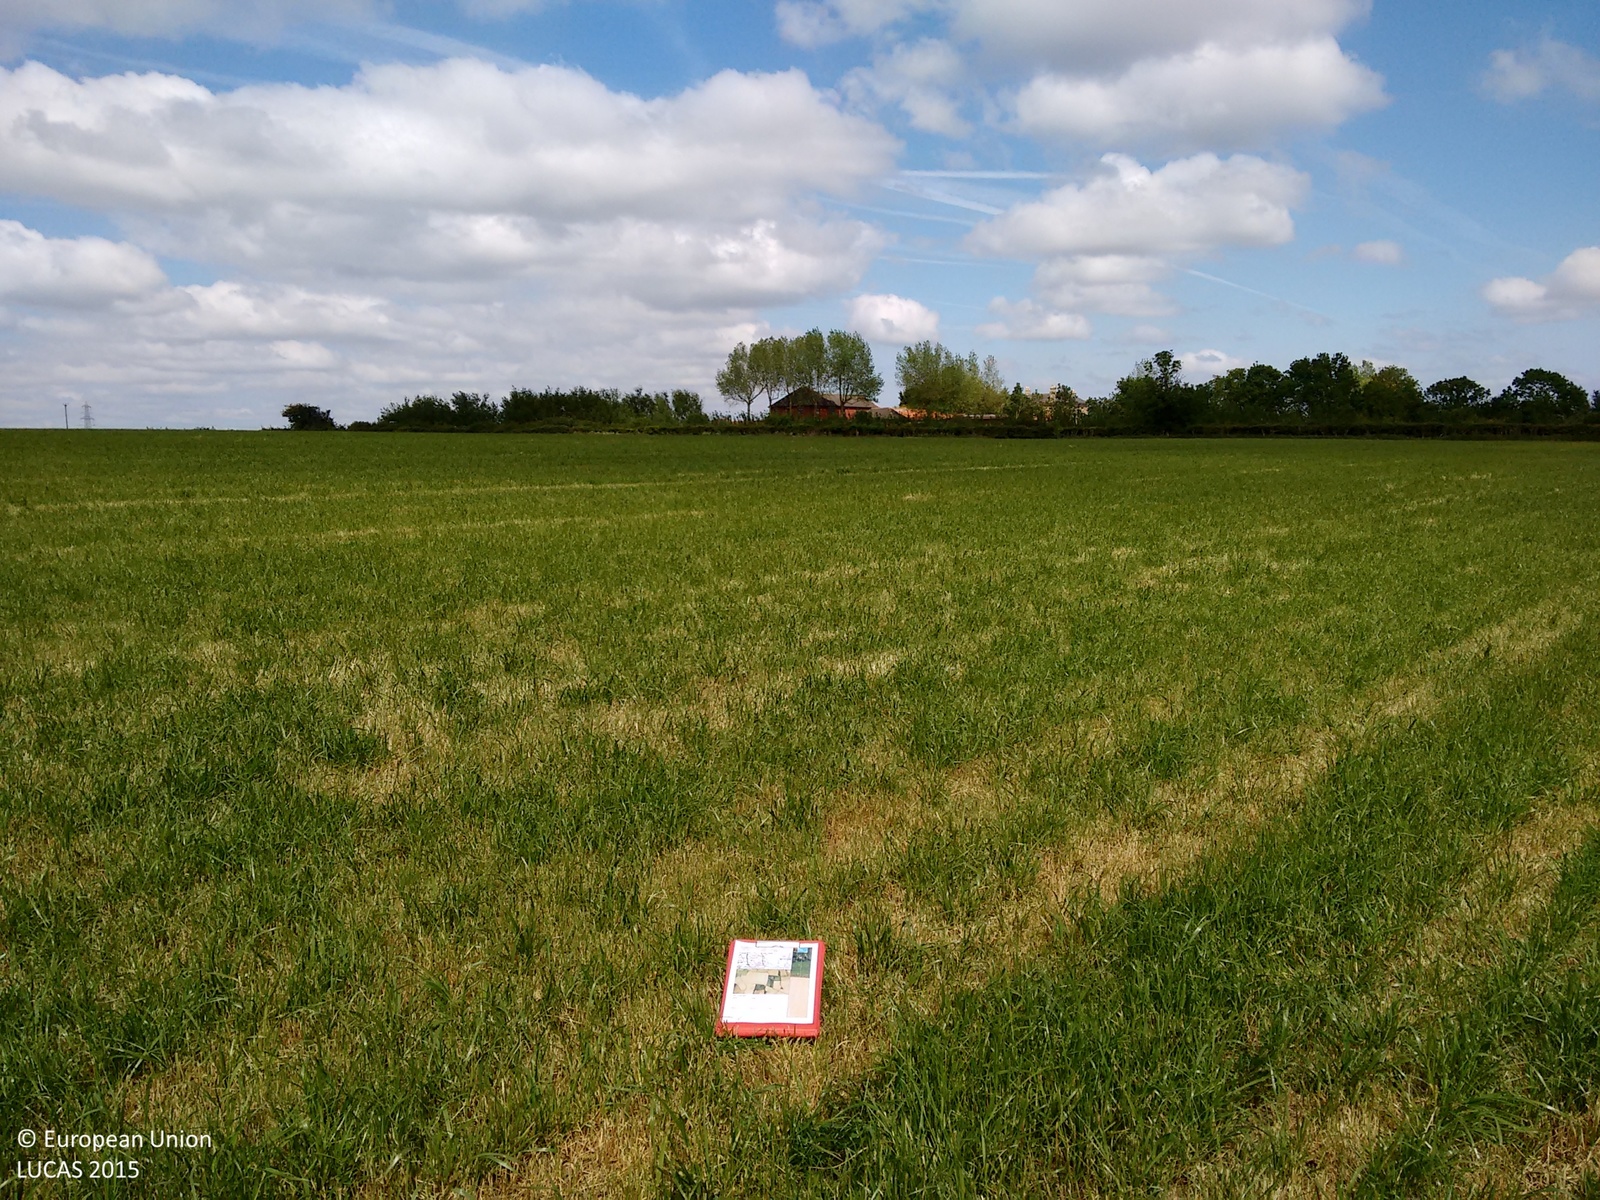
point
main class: Grassland
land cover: Grassland without tree/shrub cover
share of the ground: > 75 %
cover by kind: herbaceous plants 100 %
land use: Agriculture (excluding fallow land and kitchen gardens)
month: June
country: GB
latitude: 52.7766
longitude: -0.5488
